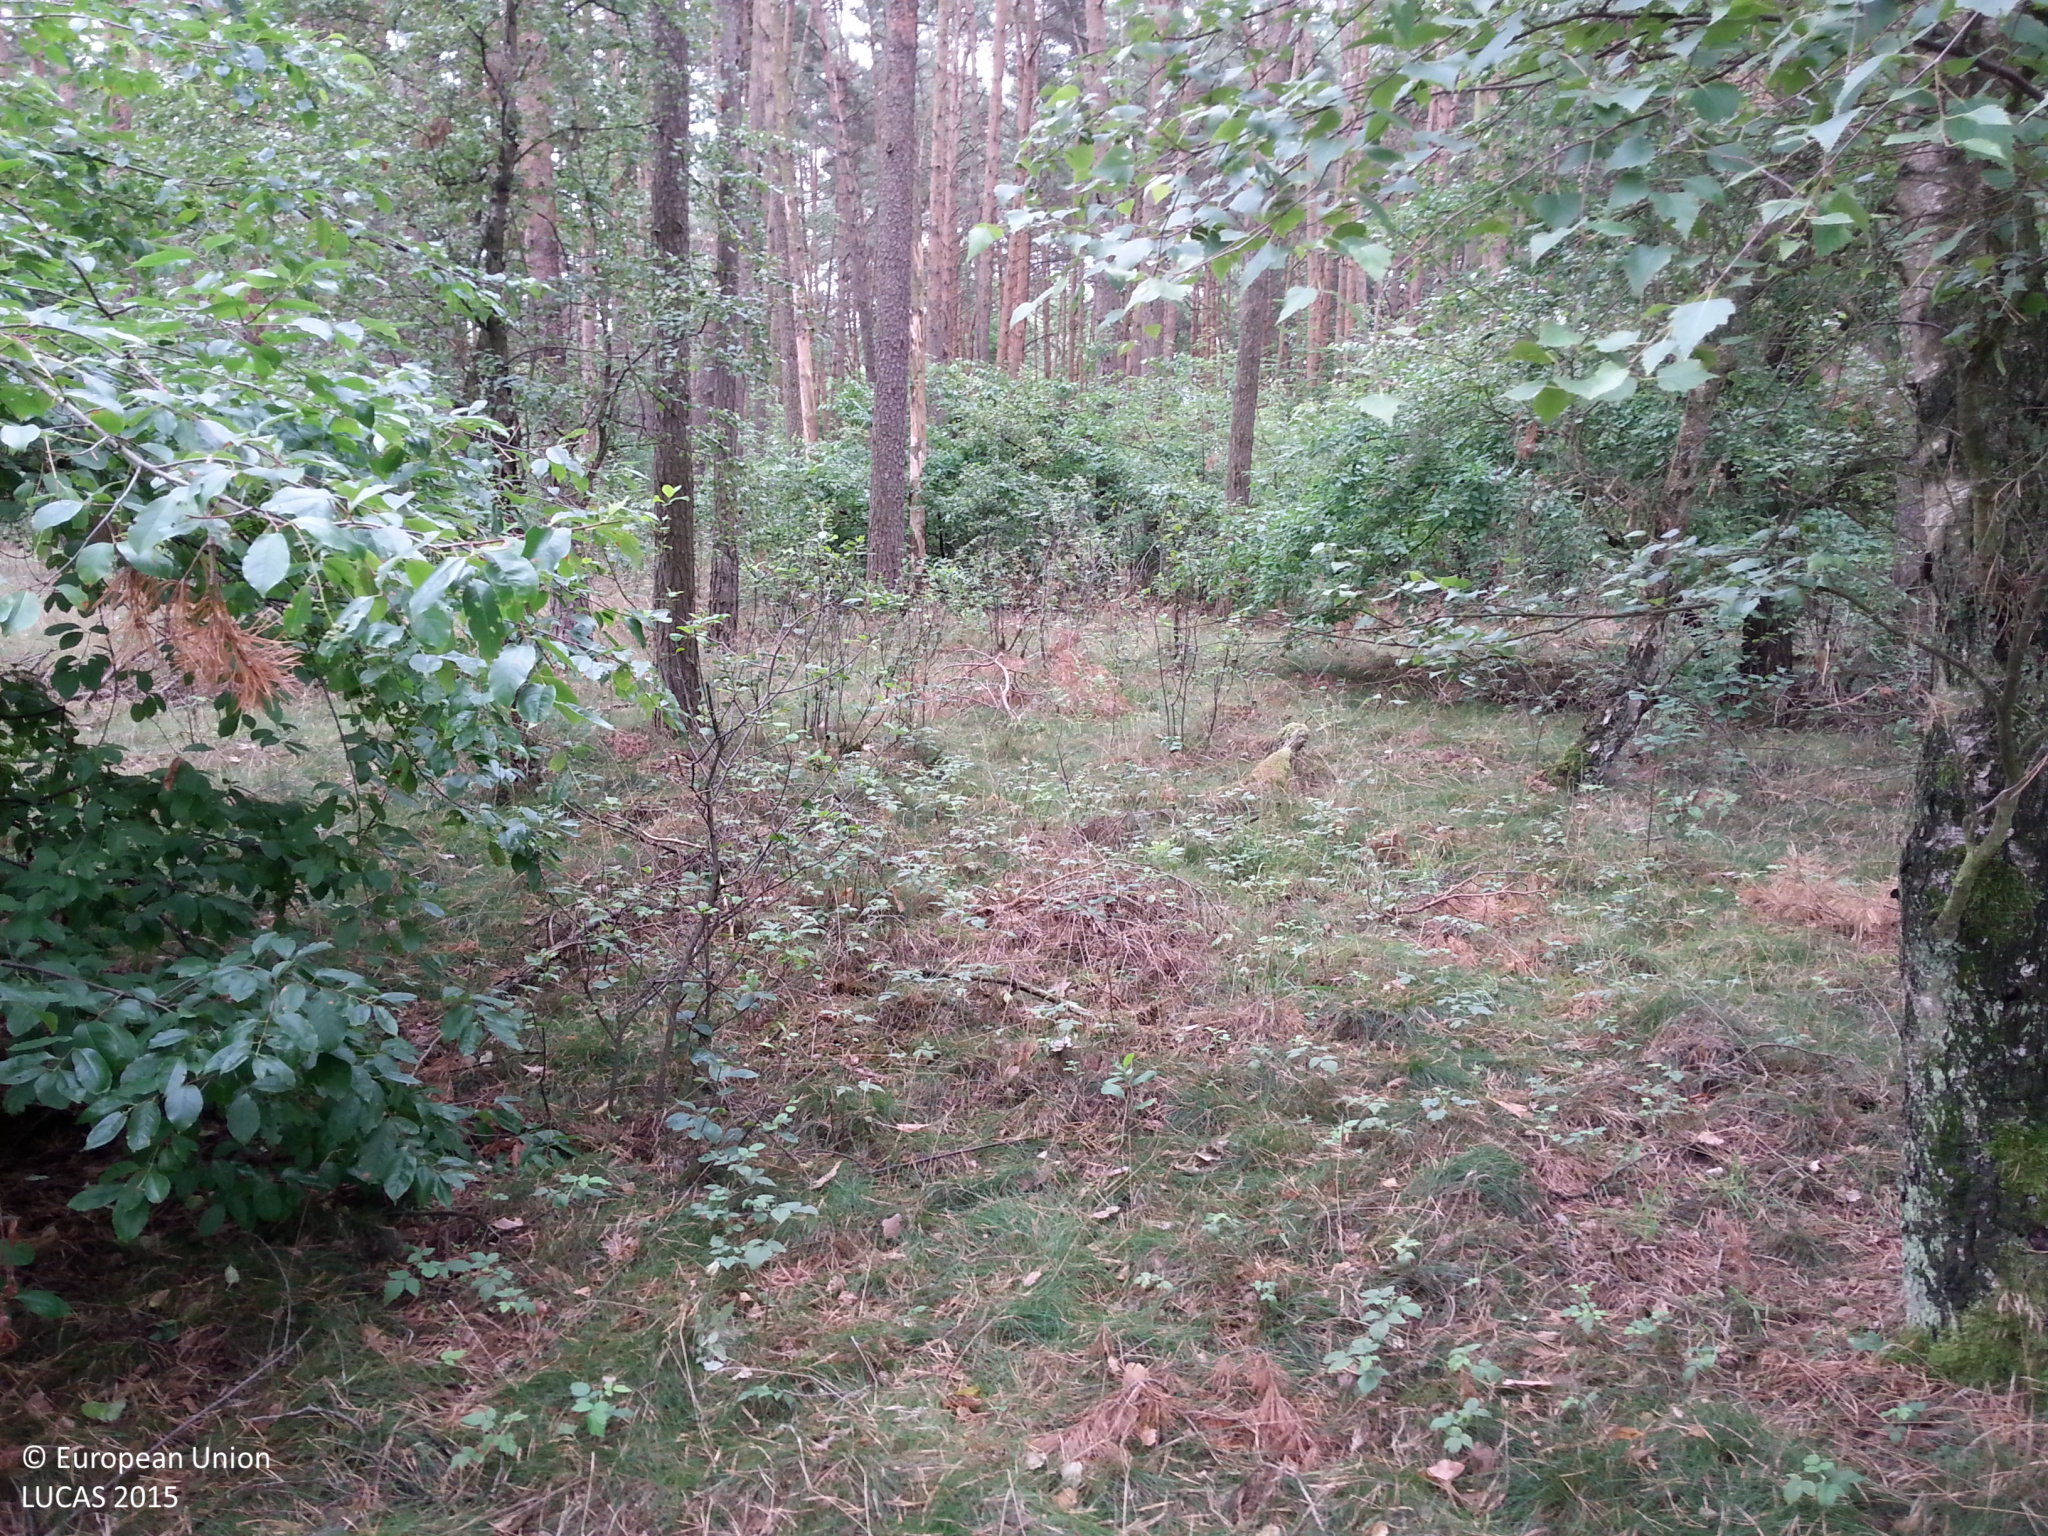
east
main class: Woodland
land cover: Pine dominated coniferous woodland
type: boreal forest
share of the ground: 50 - 75 %
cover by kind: coniferous forest trees 50 %, herbaceous plants 30 %, shrubs 15 %, lichens and mosses 5 %
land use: Forestry
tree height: > 5 m
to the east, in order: Pine dominated coniferous woodland; Paved roads, cycling and walking lanes; Broadleaved woodland; Grassland without tree/shrub cover; Railways; Grassland without tree/shrub cover; Broadleaved woodland; Maize
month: July
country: DE
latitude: 53.0377
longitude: 12.3409
